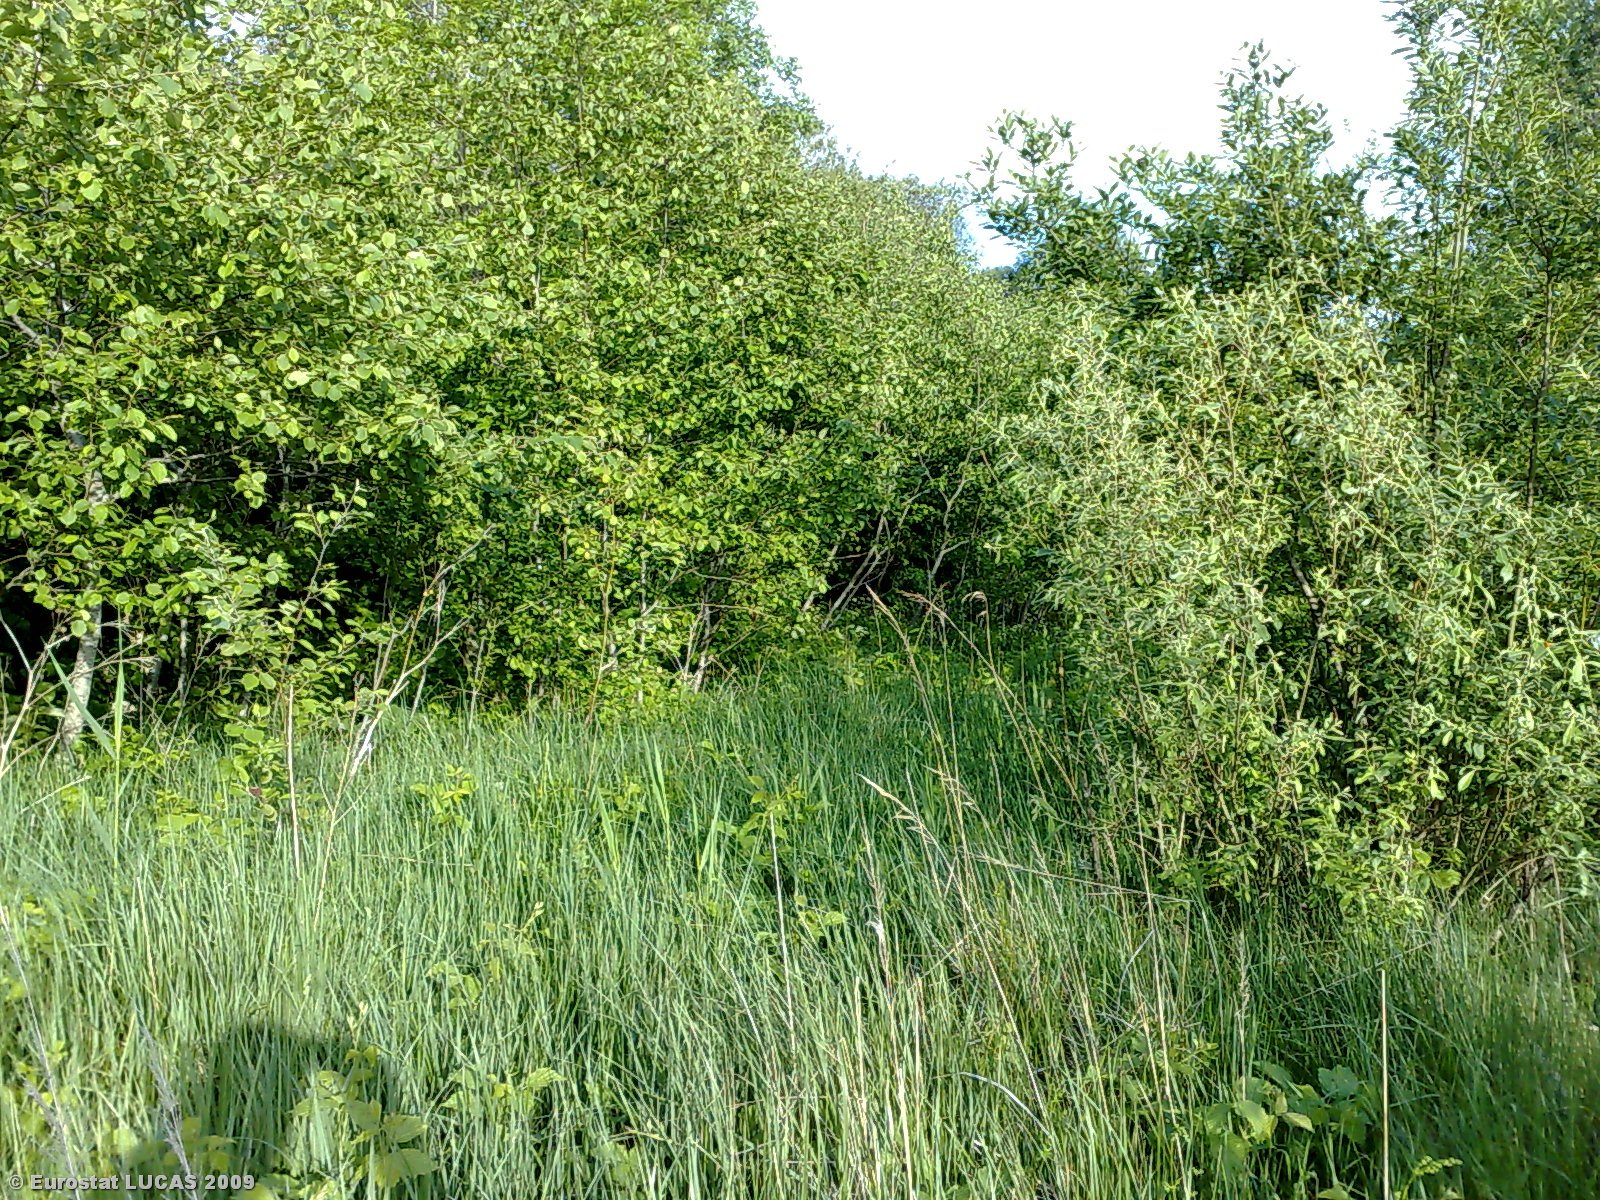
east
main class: Cropland
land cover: Rape and turnip rape
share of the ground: > 75 %
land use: Agriculture (excluding fallow land and kitchen gardens)
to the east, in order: Rape and turnip rape; Abandoned hedges; Ditches and canals; Broadleaved woodland; Ditches and canals; Broadleaved woodland
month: June
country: LT
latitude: 56.1277
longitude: 24.0028
